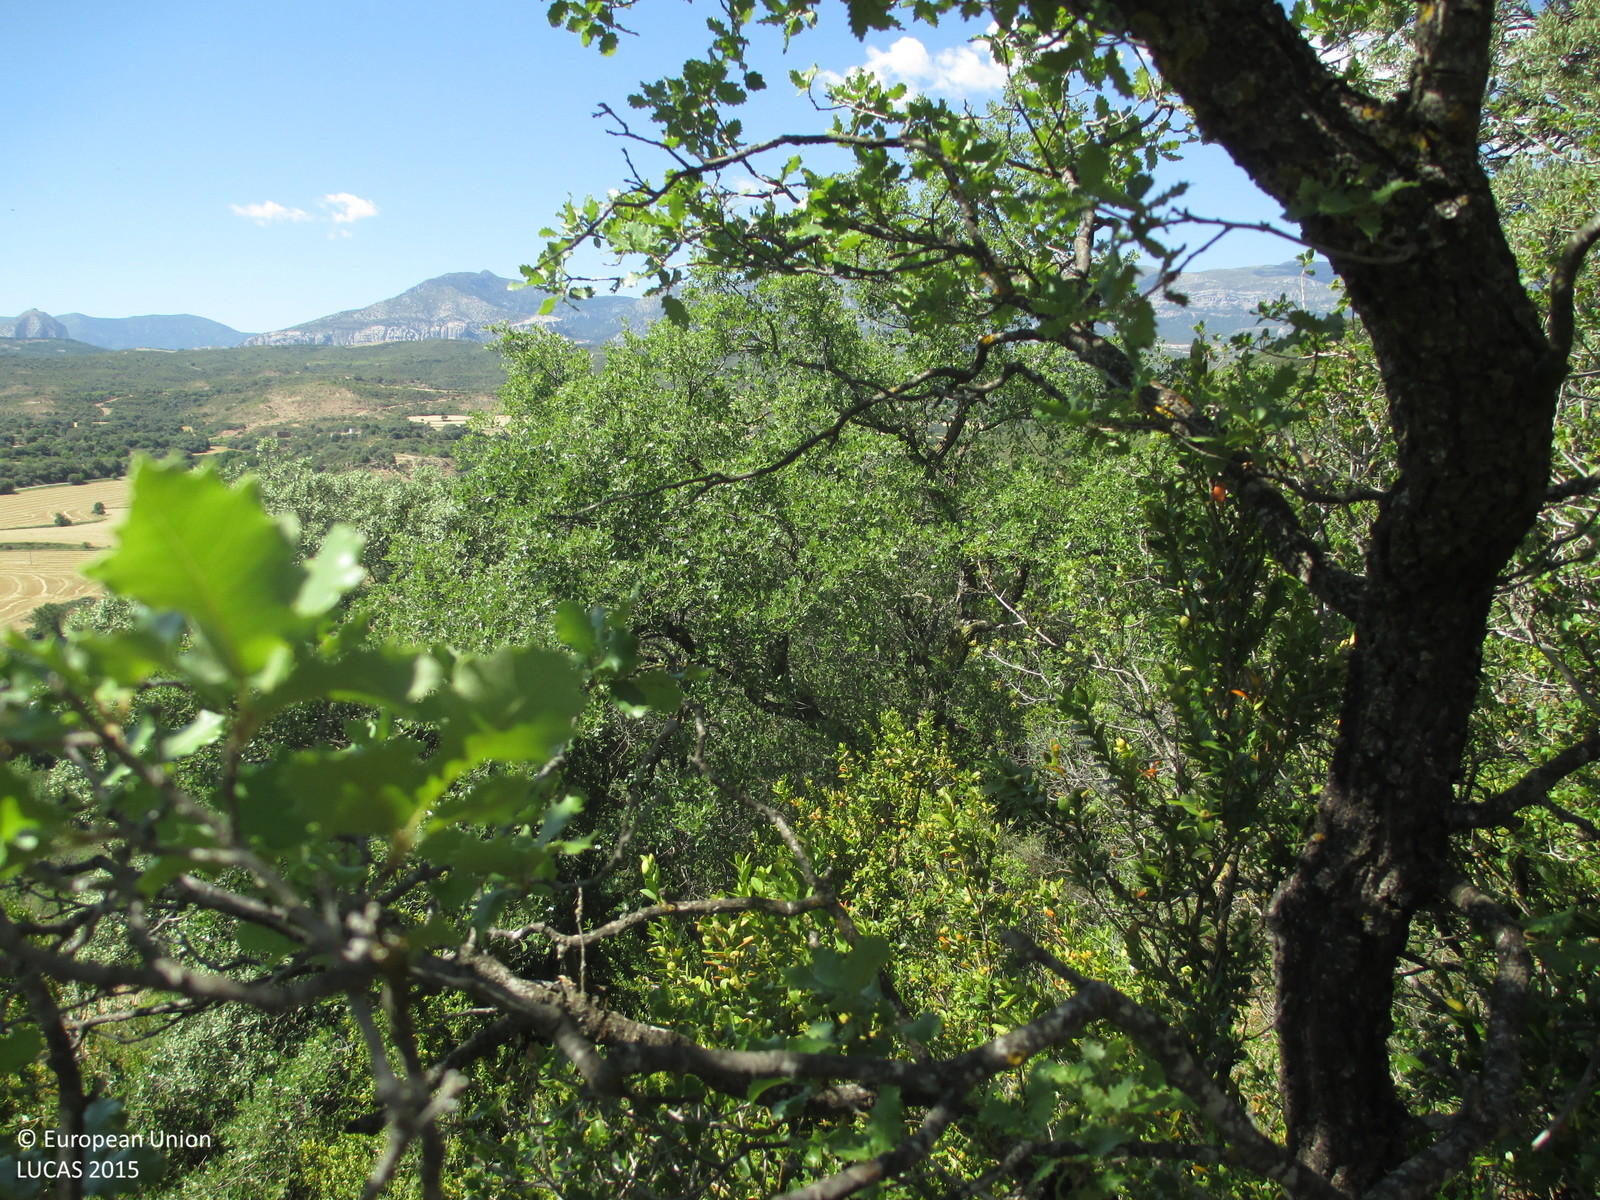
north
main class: Woodland
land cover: Broadleaved woodland
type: broadleaved evergreen forest
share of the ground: > 75 %
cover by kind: broadleaved forest trees 95 %, shrubs 5 %
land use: Semi-natural and natural areas not in use
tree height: < 5 m
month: June
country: ES
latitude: 42.1894
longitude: -0.2294
